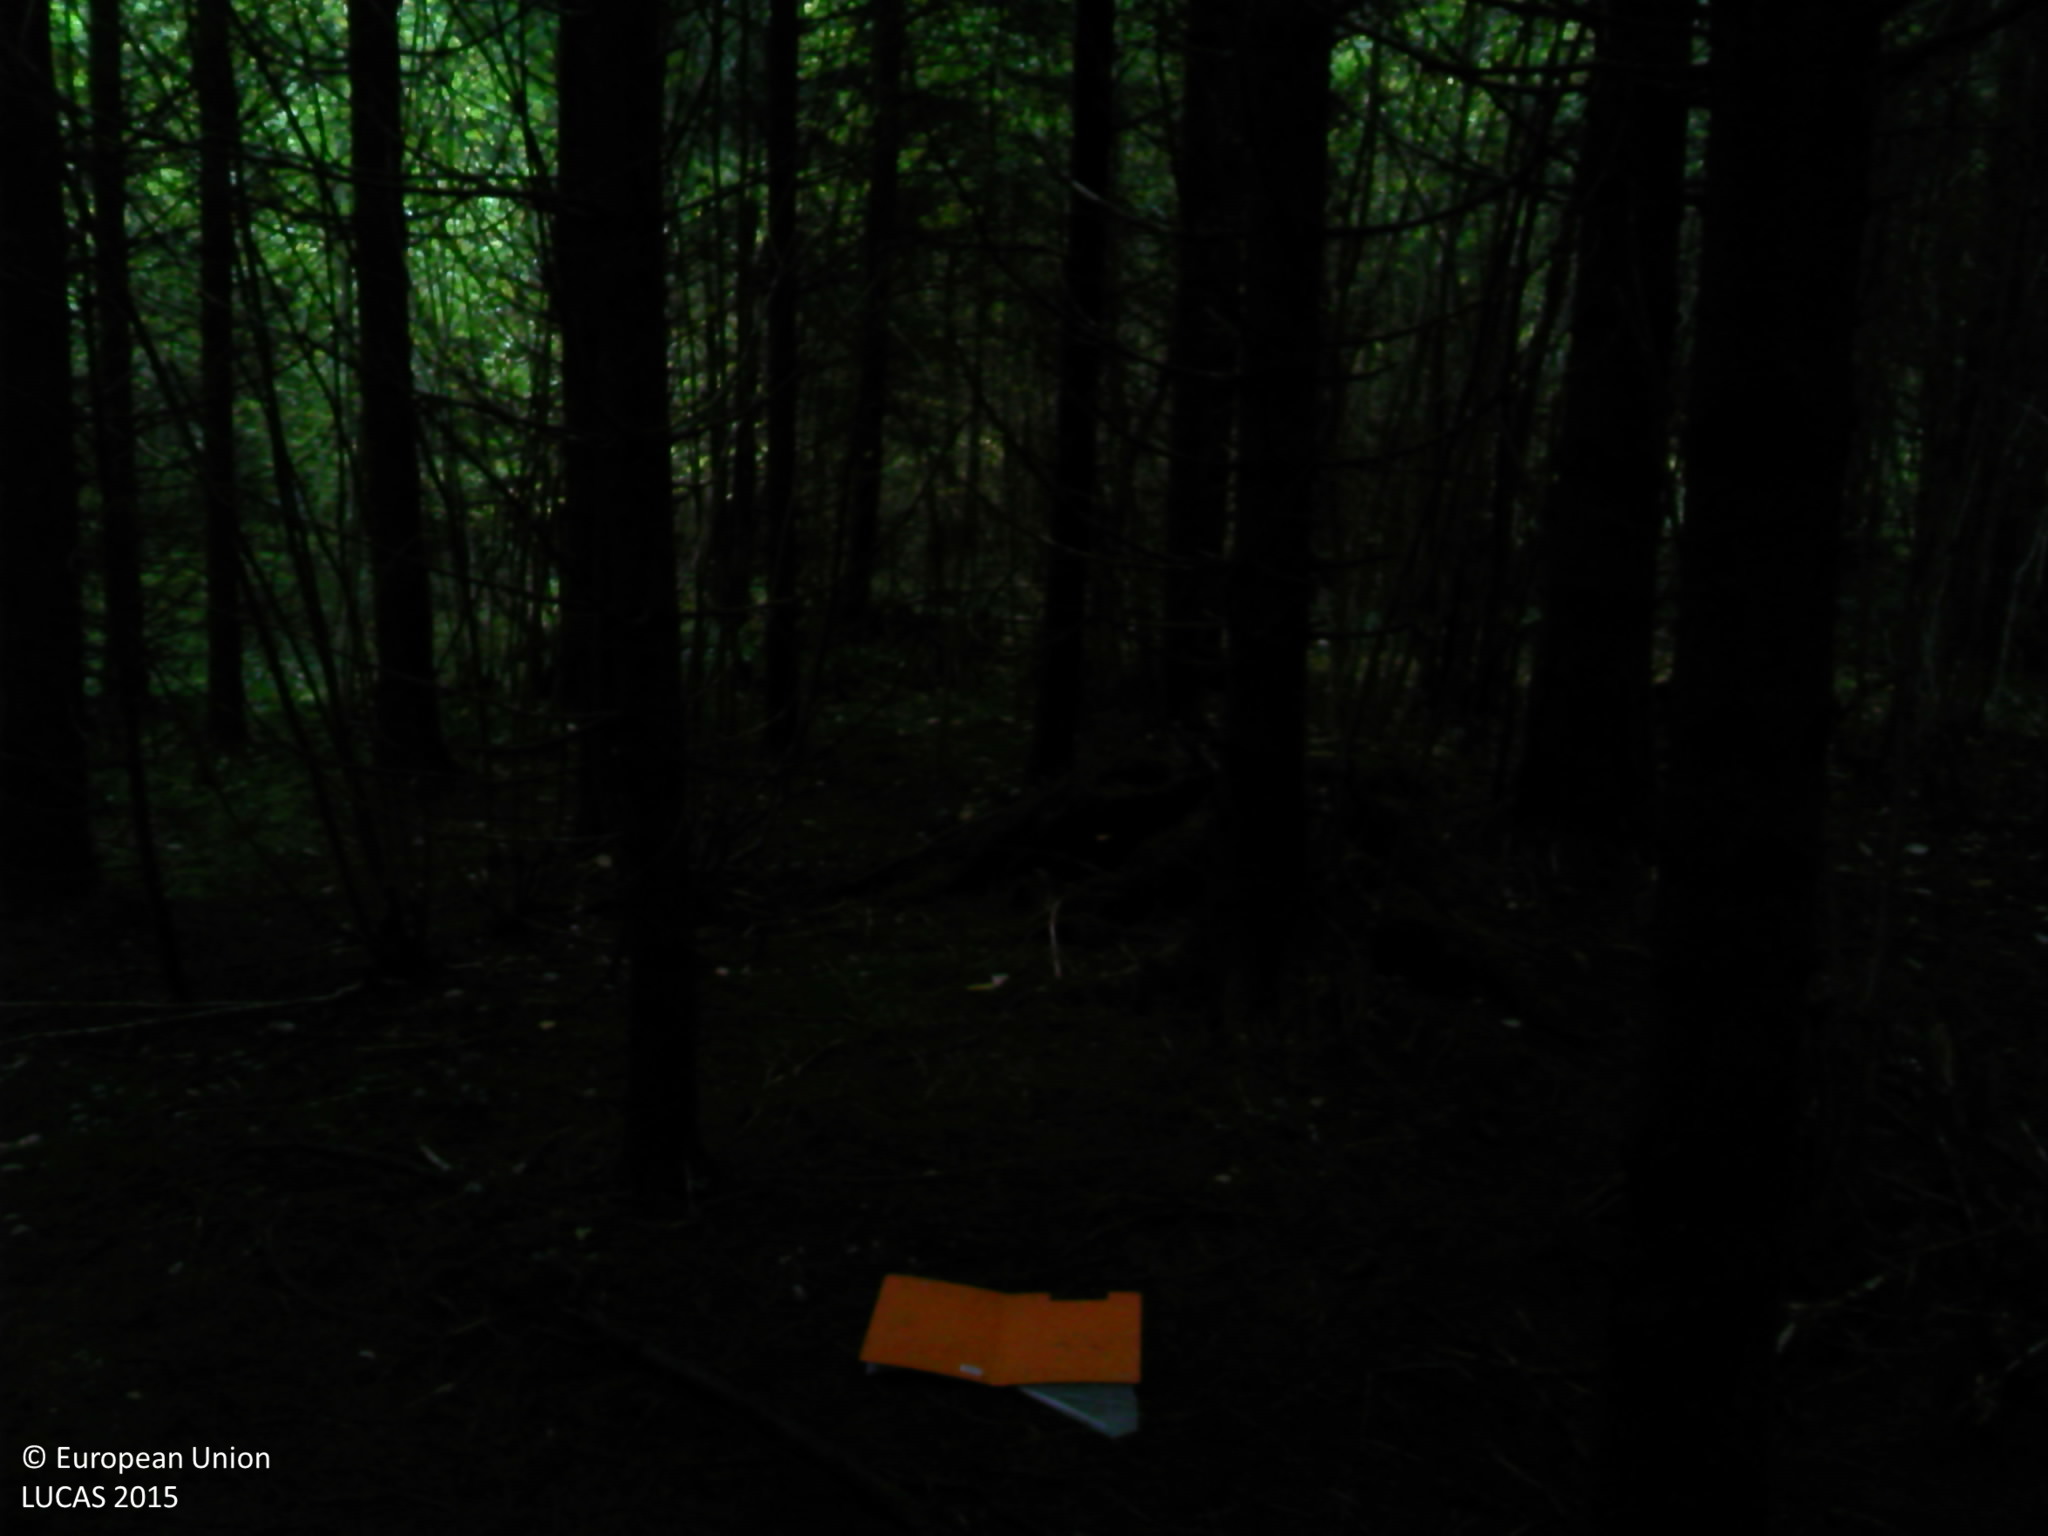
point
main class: Woodland
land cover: Spruce dominated coniferous woodland
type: alpine coniferous forest
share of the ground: > 75 %
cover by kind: coniferous forest trees 100 %
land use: Forestry
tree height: > 5 m
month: October
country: FR
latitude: 46.9463
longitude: 6.0740
